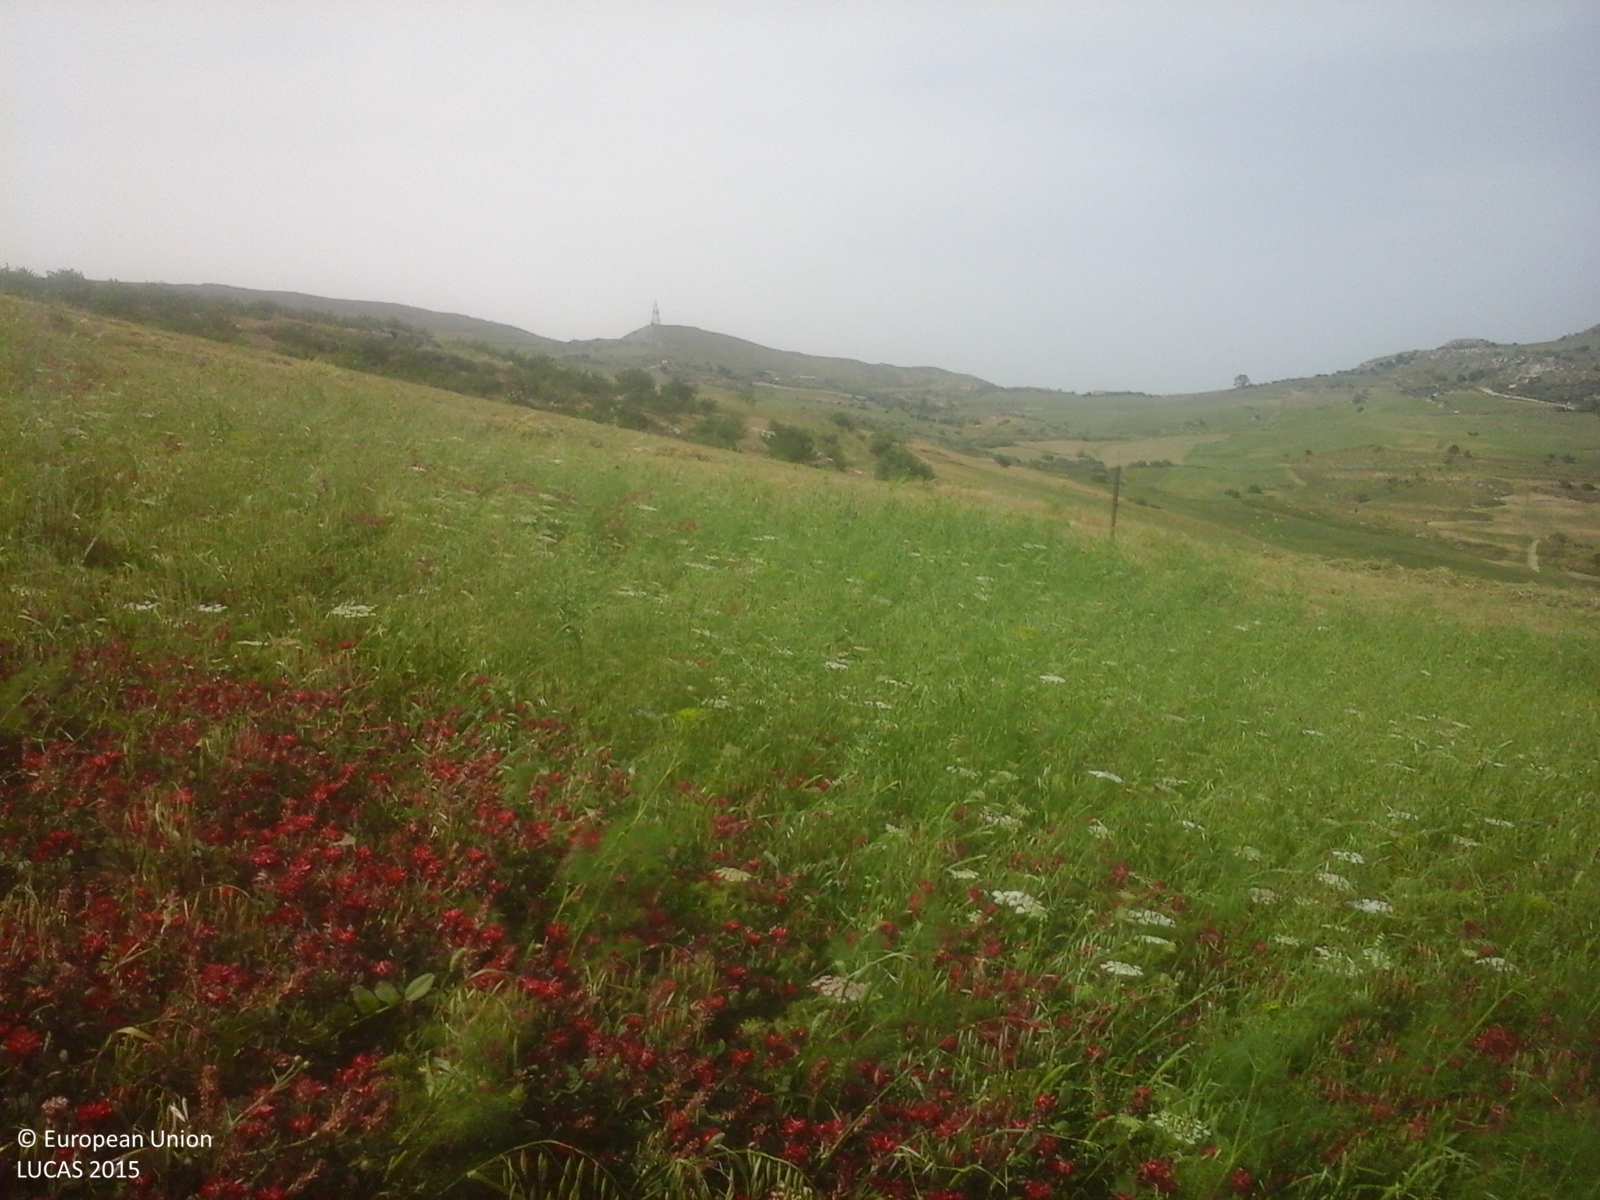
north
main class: Cropland
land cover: Temporary grasslands
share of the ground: > 75 %
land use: Agriculture (excluding fallow land and kitchen gardens)
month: May
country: IT
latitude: 37.5930
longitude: 13.9461
